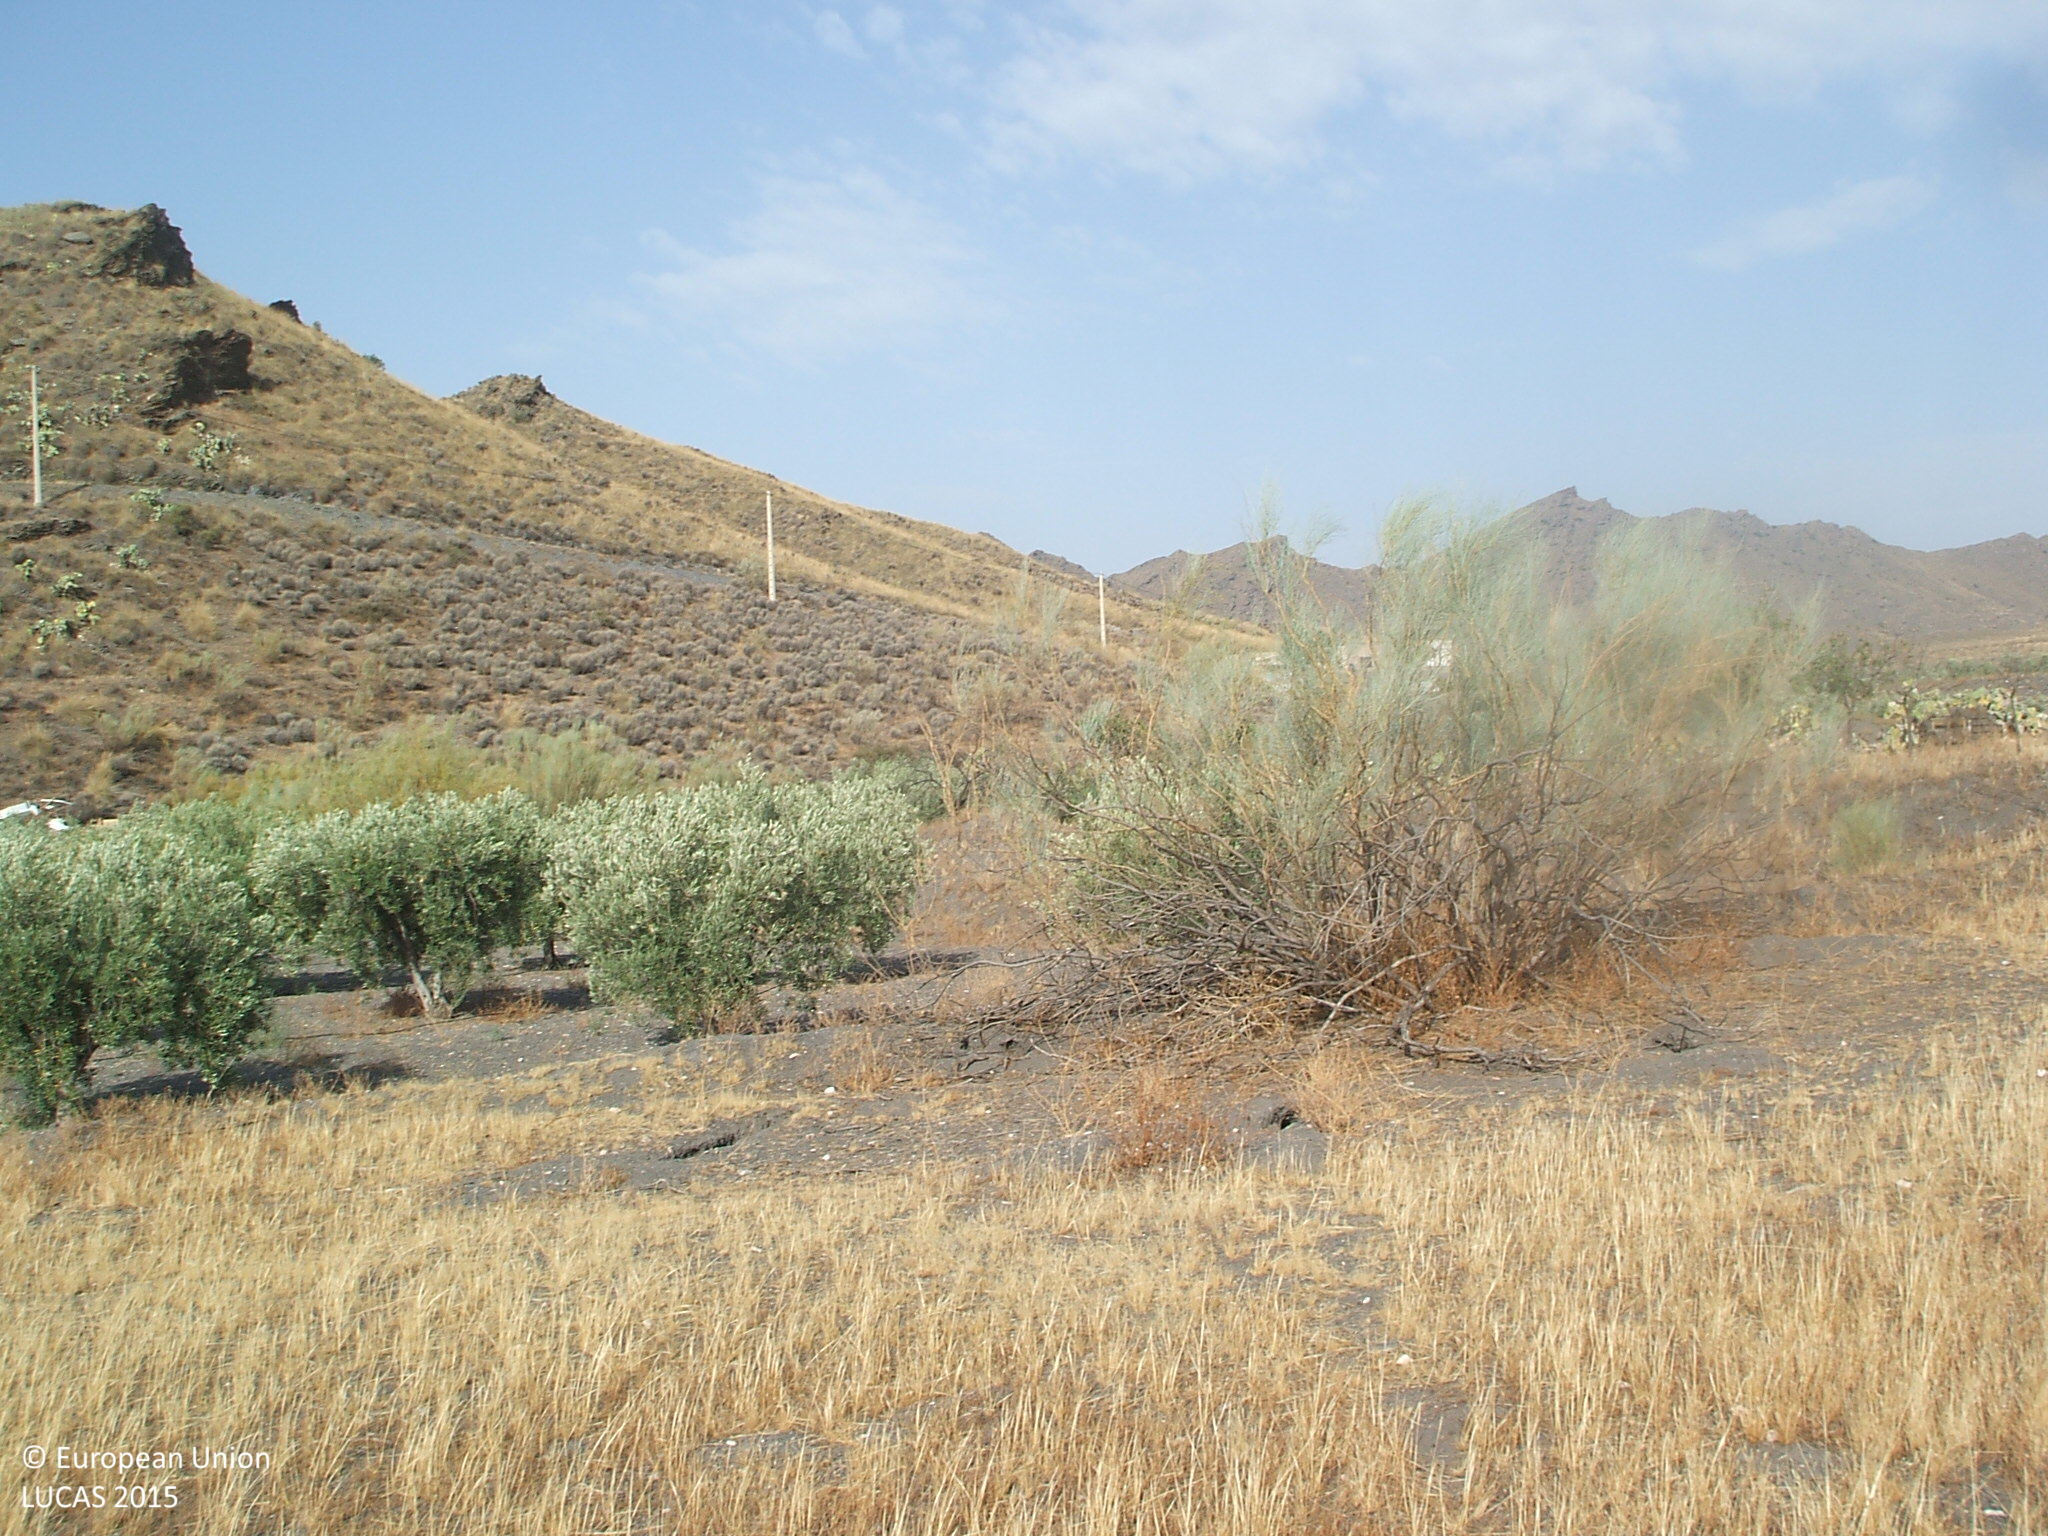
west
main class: Shrubland
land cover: Shrubland without tree cover
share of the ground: 10 - 25 %
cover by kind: herbaceous plants 85 %, shrubs 15 %
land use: Semi-natural and natural areas not in use
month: July
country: ES
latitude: 37.1227
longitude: -2.3481
